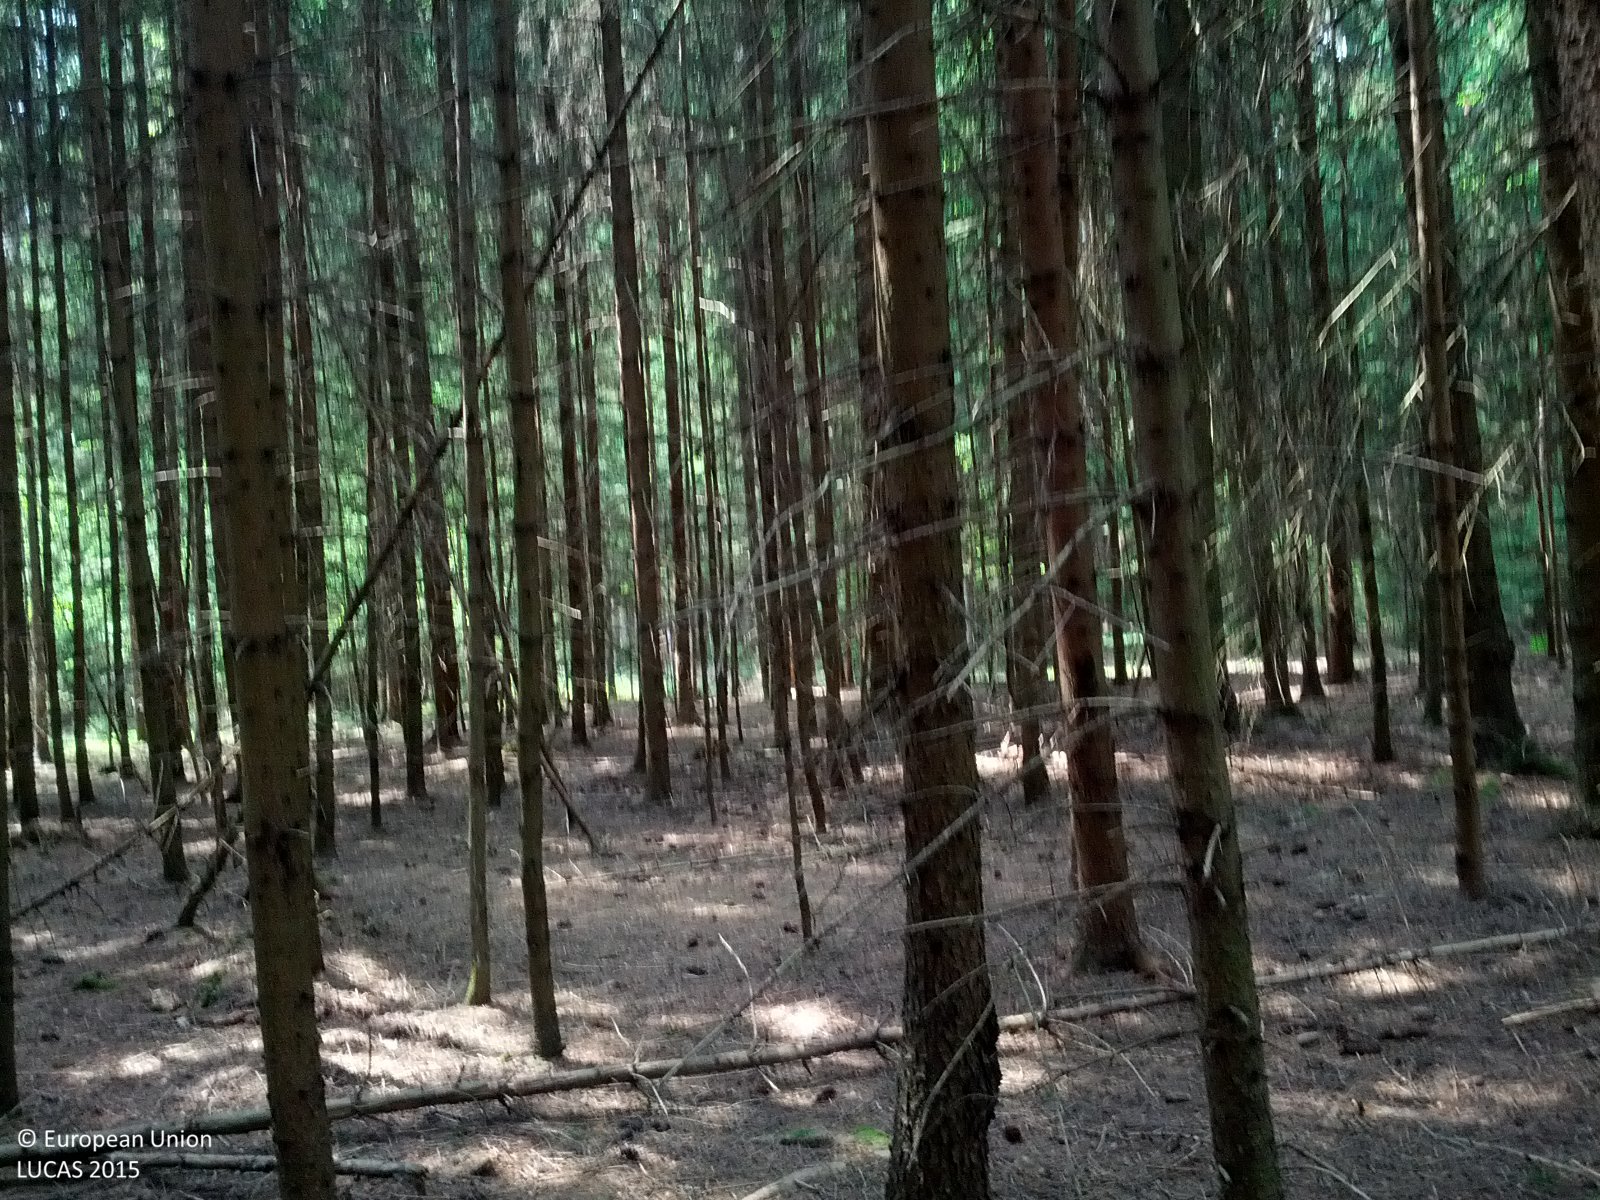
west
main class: Woodland
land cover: Spruce dominated coniferous woodland
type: boreal forest
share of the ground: > 75 %
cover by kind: coniferous forest trees 70 %, unconsolidated bare surface 30 %
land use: Forestry
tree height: > 5 m
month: May
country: AT
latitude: 47.3116
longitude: 16.1533
